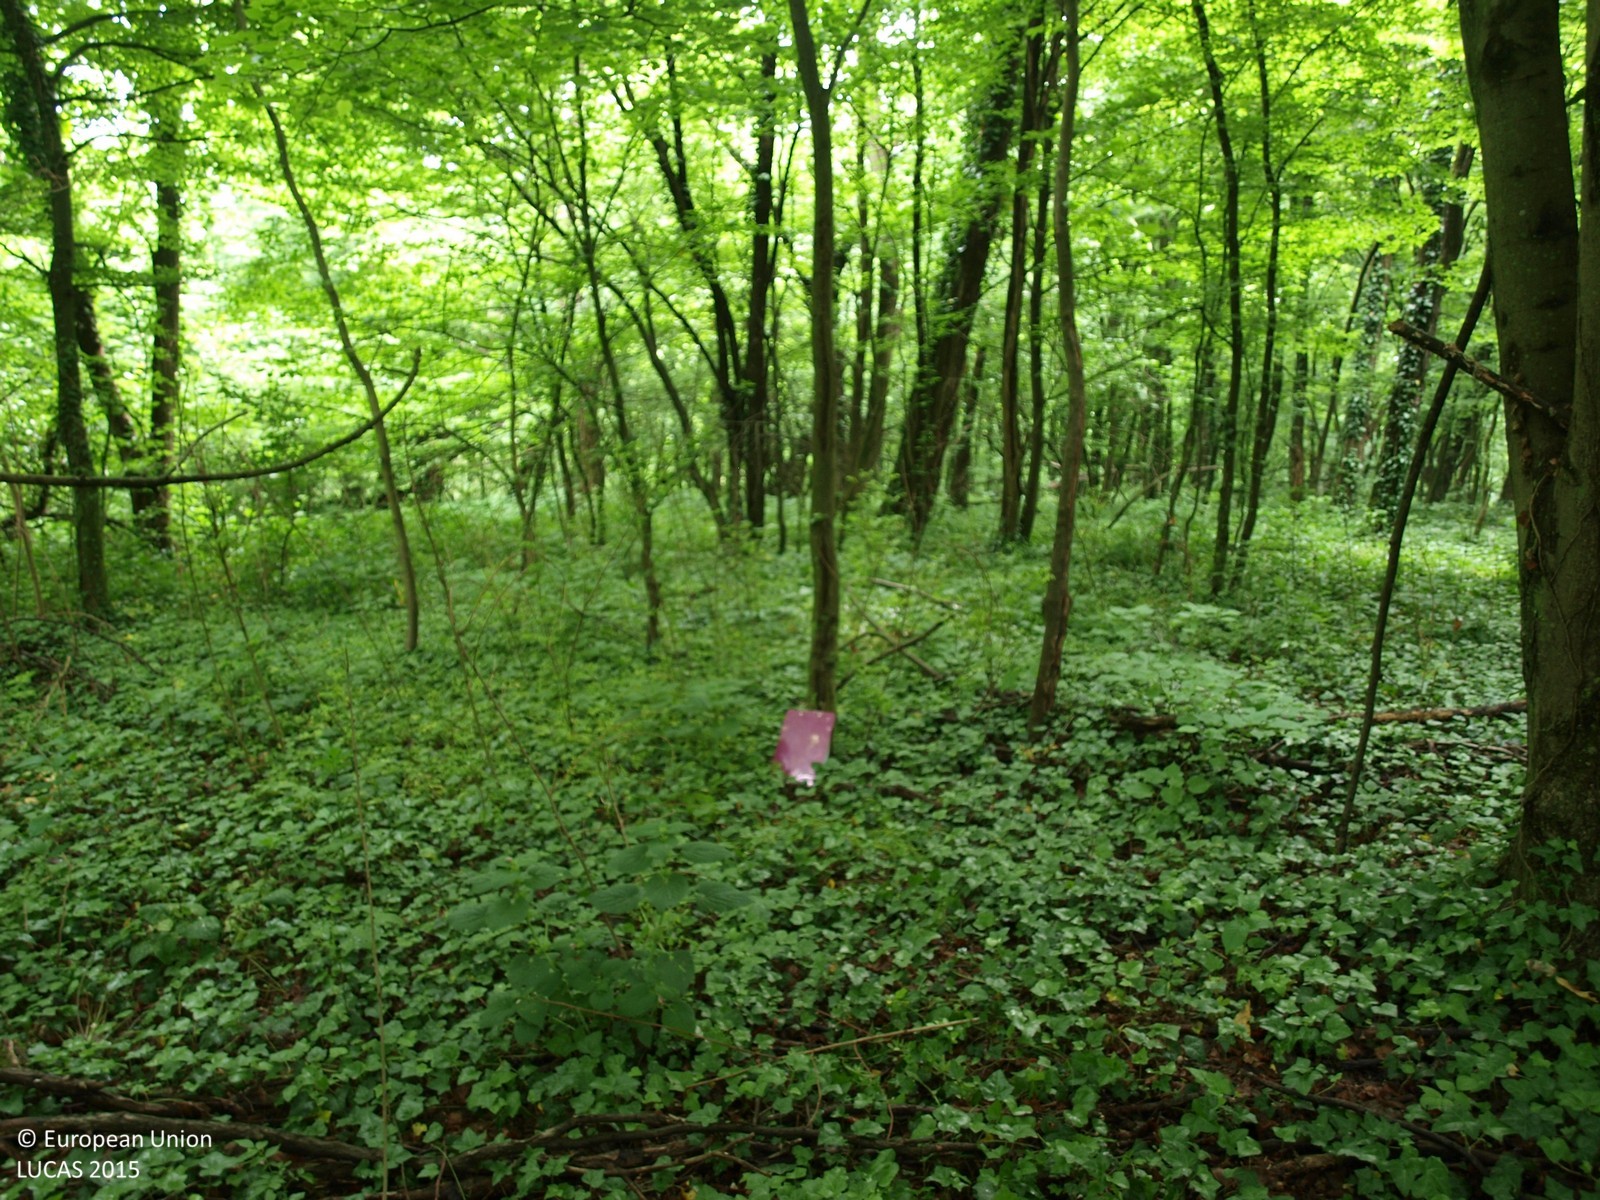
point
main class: Woodland
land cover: Broadleaved woodland
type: mesophytic deciduous forest
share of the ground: > 75 %
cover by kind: broadleaved forest trees 95 %, herbaceous plants 5 %
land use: Forestry
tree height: > 5 m
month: May
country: HR
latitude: 46.0993
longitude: 16.1953
